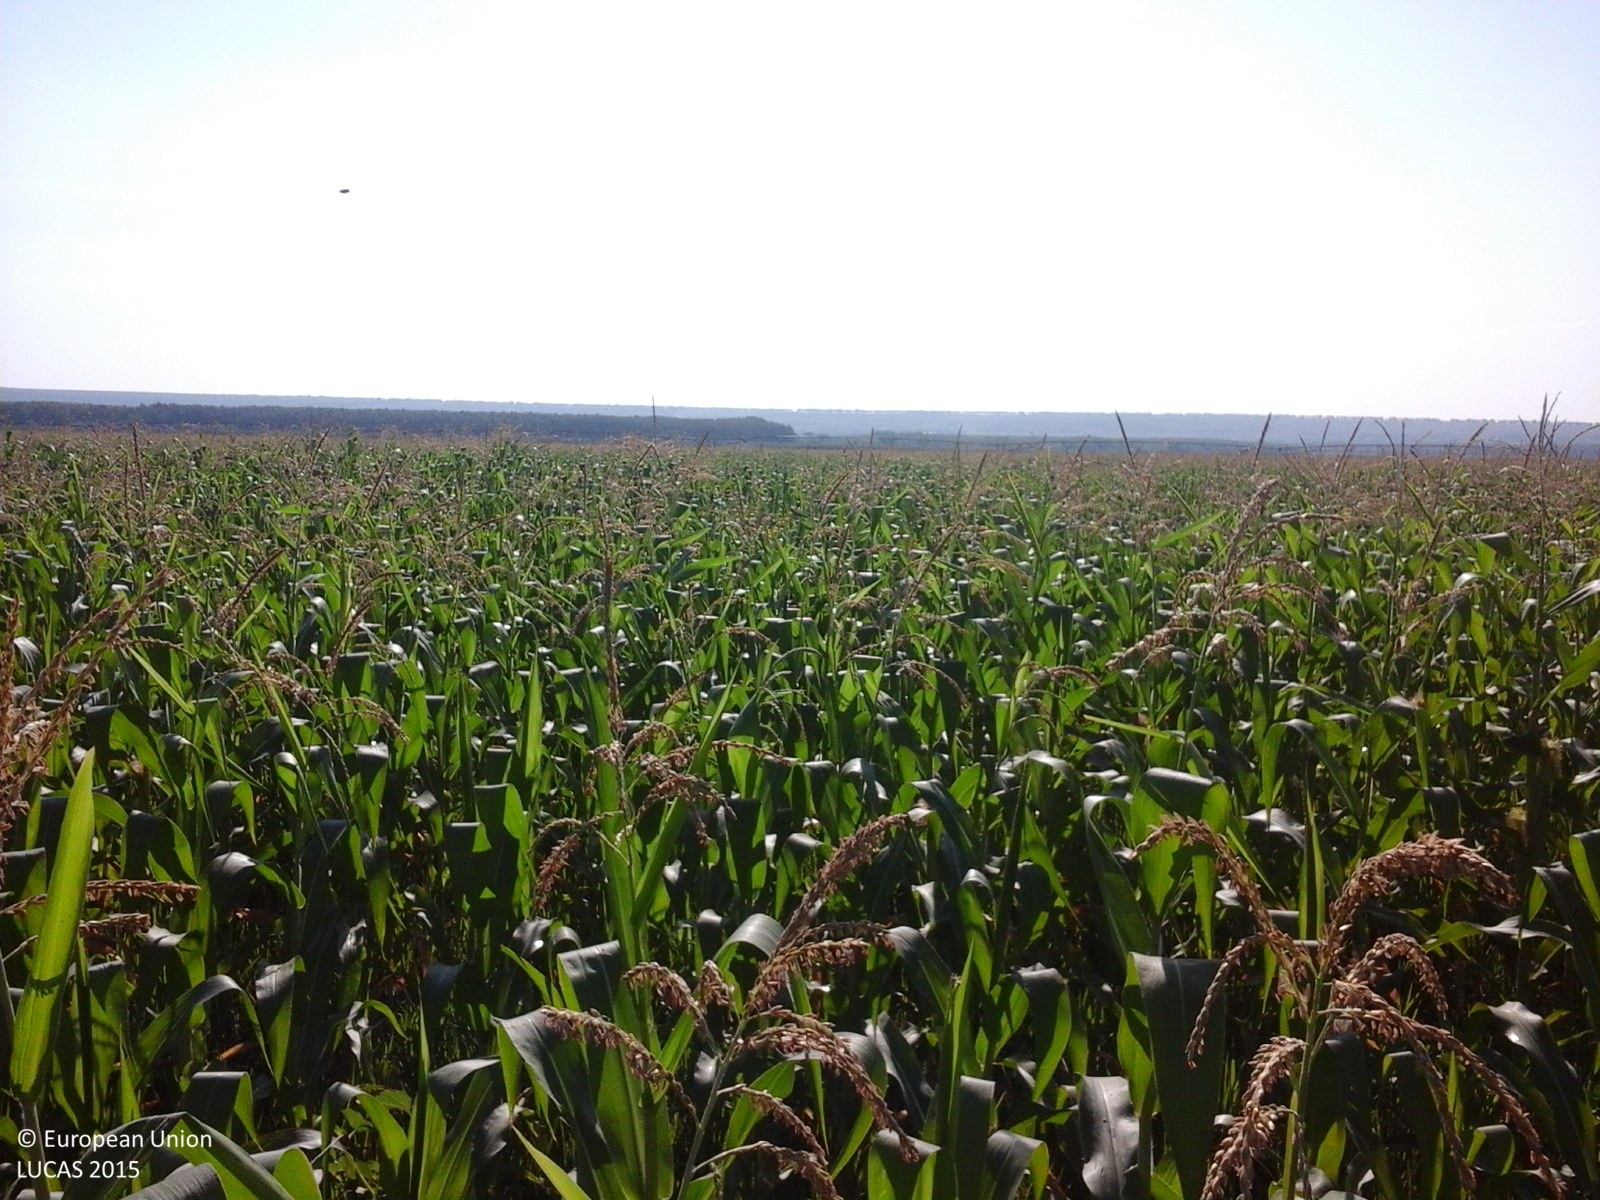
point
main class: Cropland
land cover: Maize
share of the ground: > 75 %
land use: Agriculture (excluding fallow land and kitchen gardens)
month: July
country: RO
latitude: 46.3269
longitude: 28.1725
